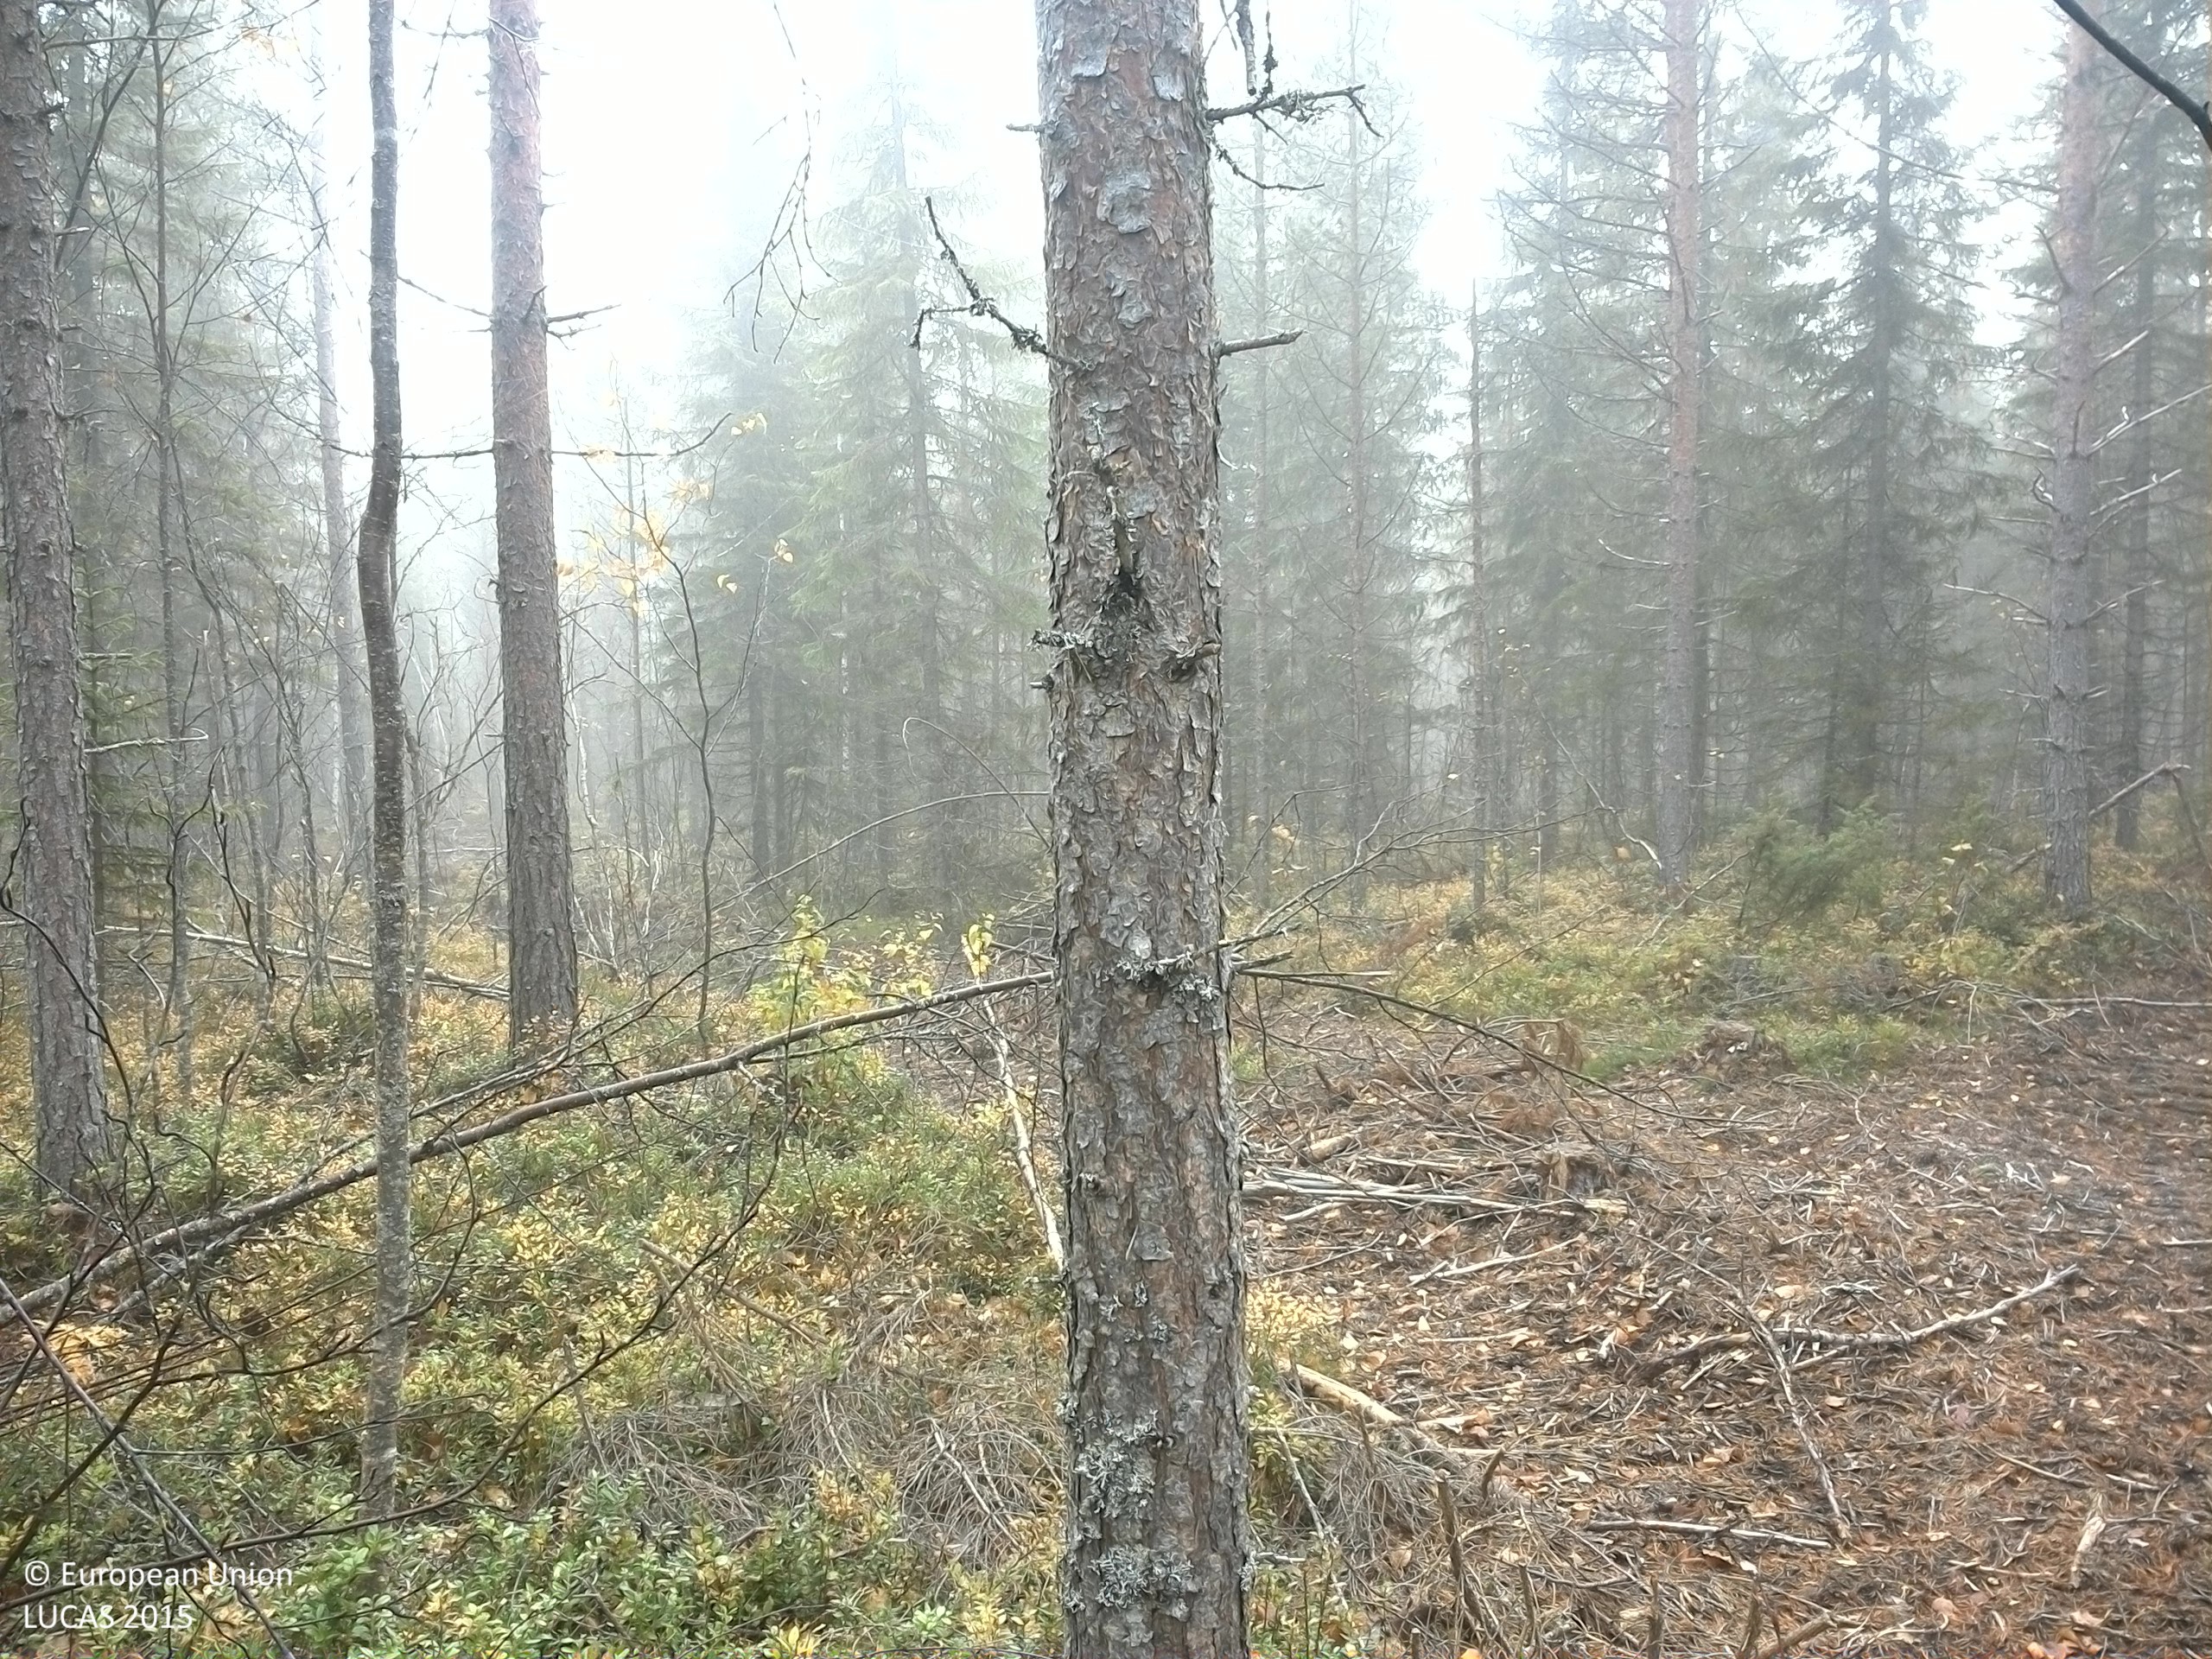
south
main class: Woodland
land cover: Pine dominated mixed woodland
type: boreal forest
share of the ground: 50 - 75 %
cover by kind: coniferous forest trees 45 %, shrubs 30 %, broadleaved forest trees 15 %, lichens and mosses 10 %
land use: Forestry
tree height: > 5 m
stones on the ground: 10 - 25 %
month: October
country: SE
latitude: 64.0017
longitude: 16.2893
